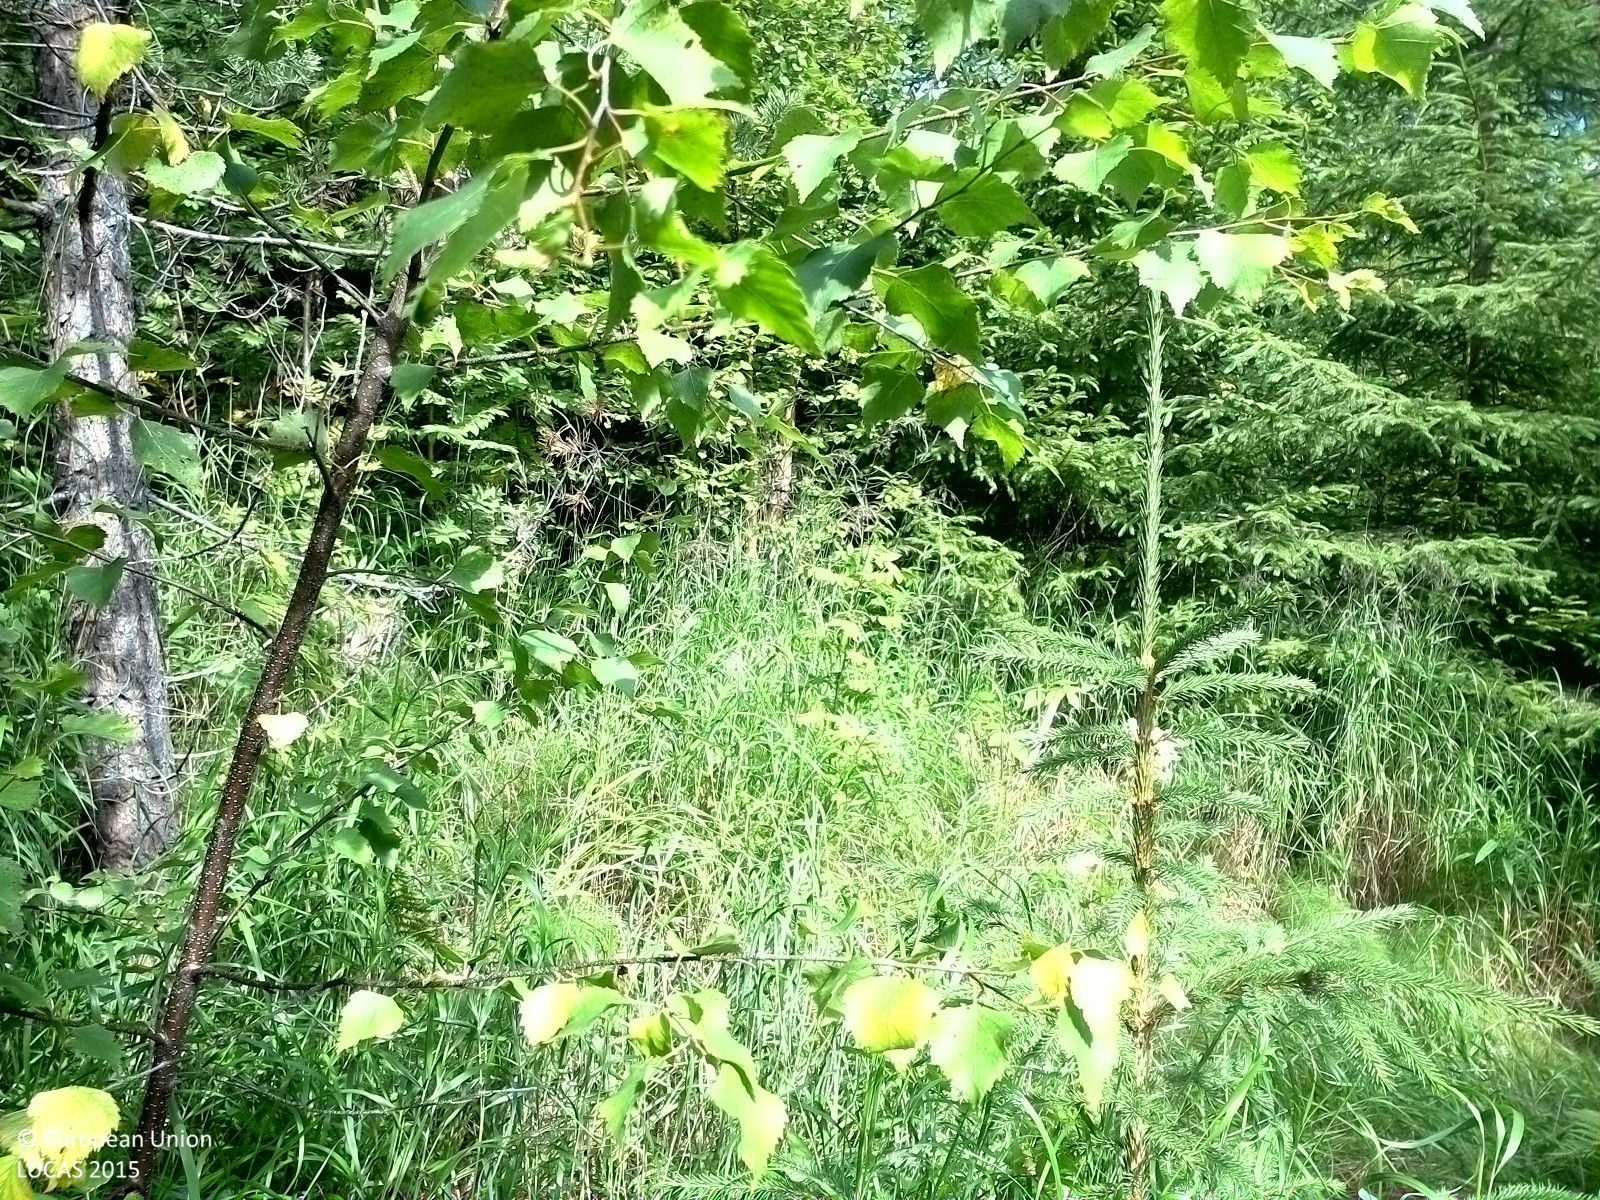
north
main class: Woodland
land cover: Other mixed woodland
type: boreal forest
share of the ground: 50 - 75 %
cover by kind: herbaceous plants 45 %, broadleaved forest trees 40 %, coniferous forest trees 15 %
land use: Semi-natural and natural areas not in use
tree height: < 5 m
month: August
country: SE
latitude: 62.5114
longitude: 17.2233
